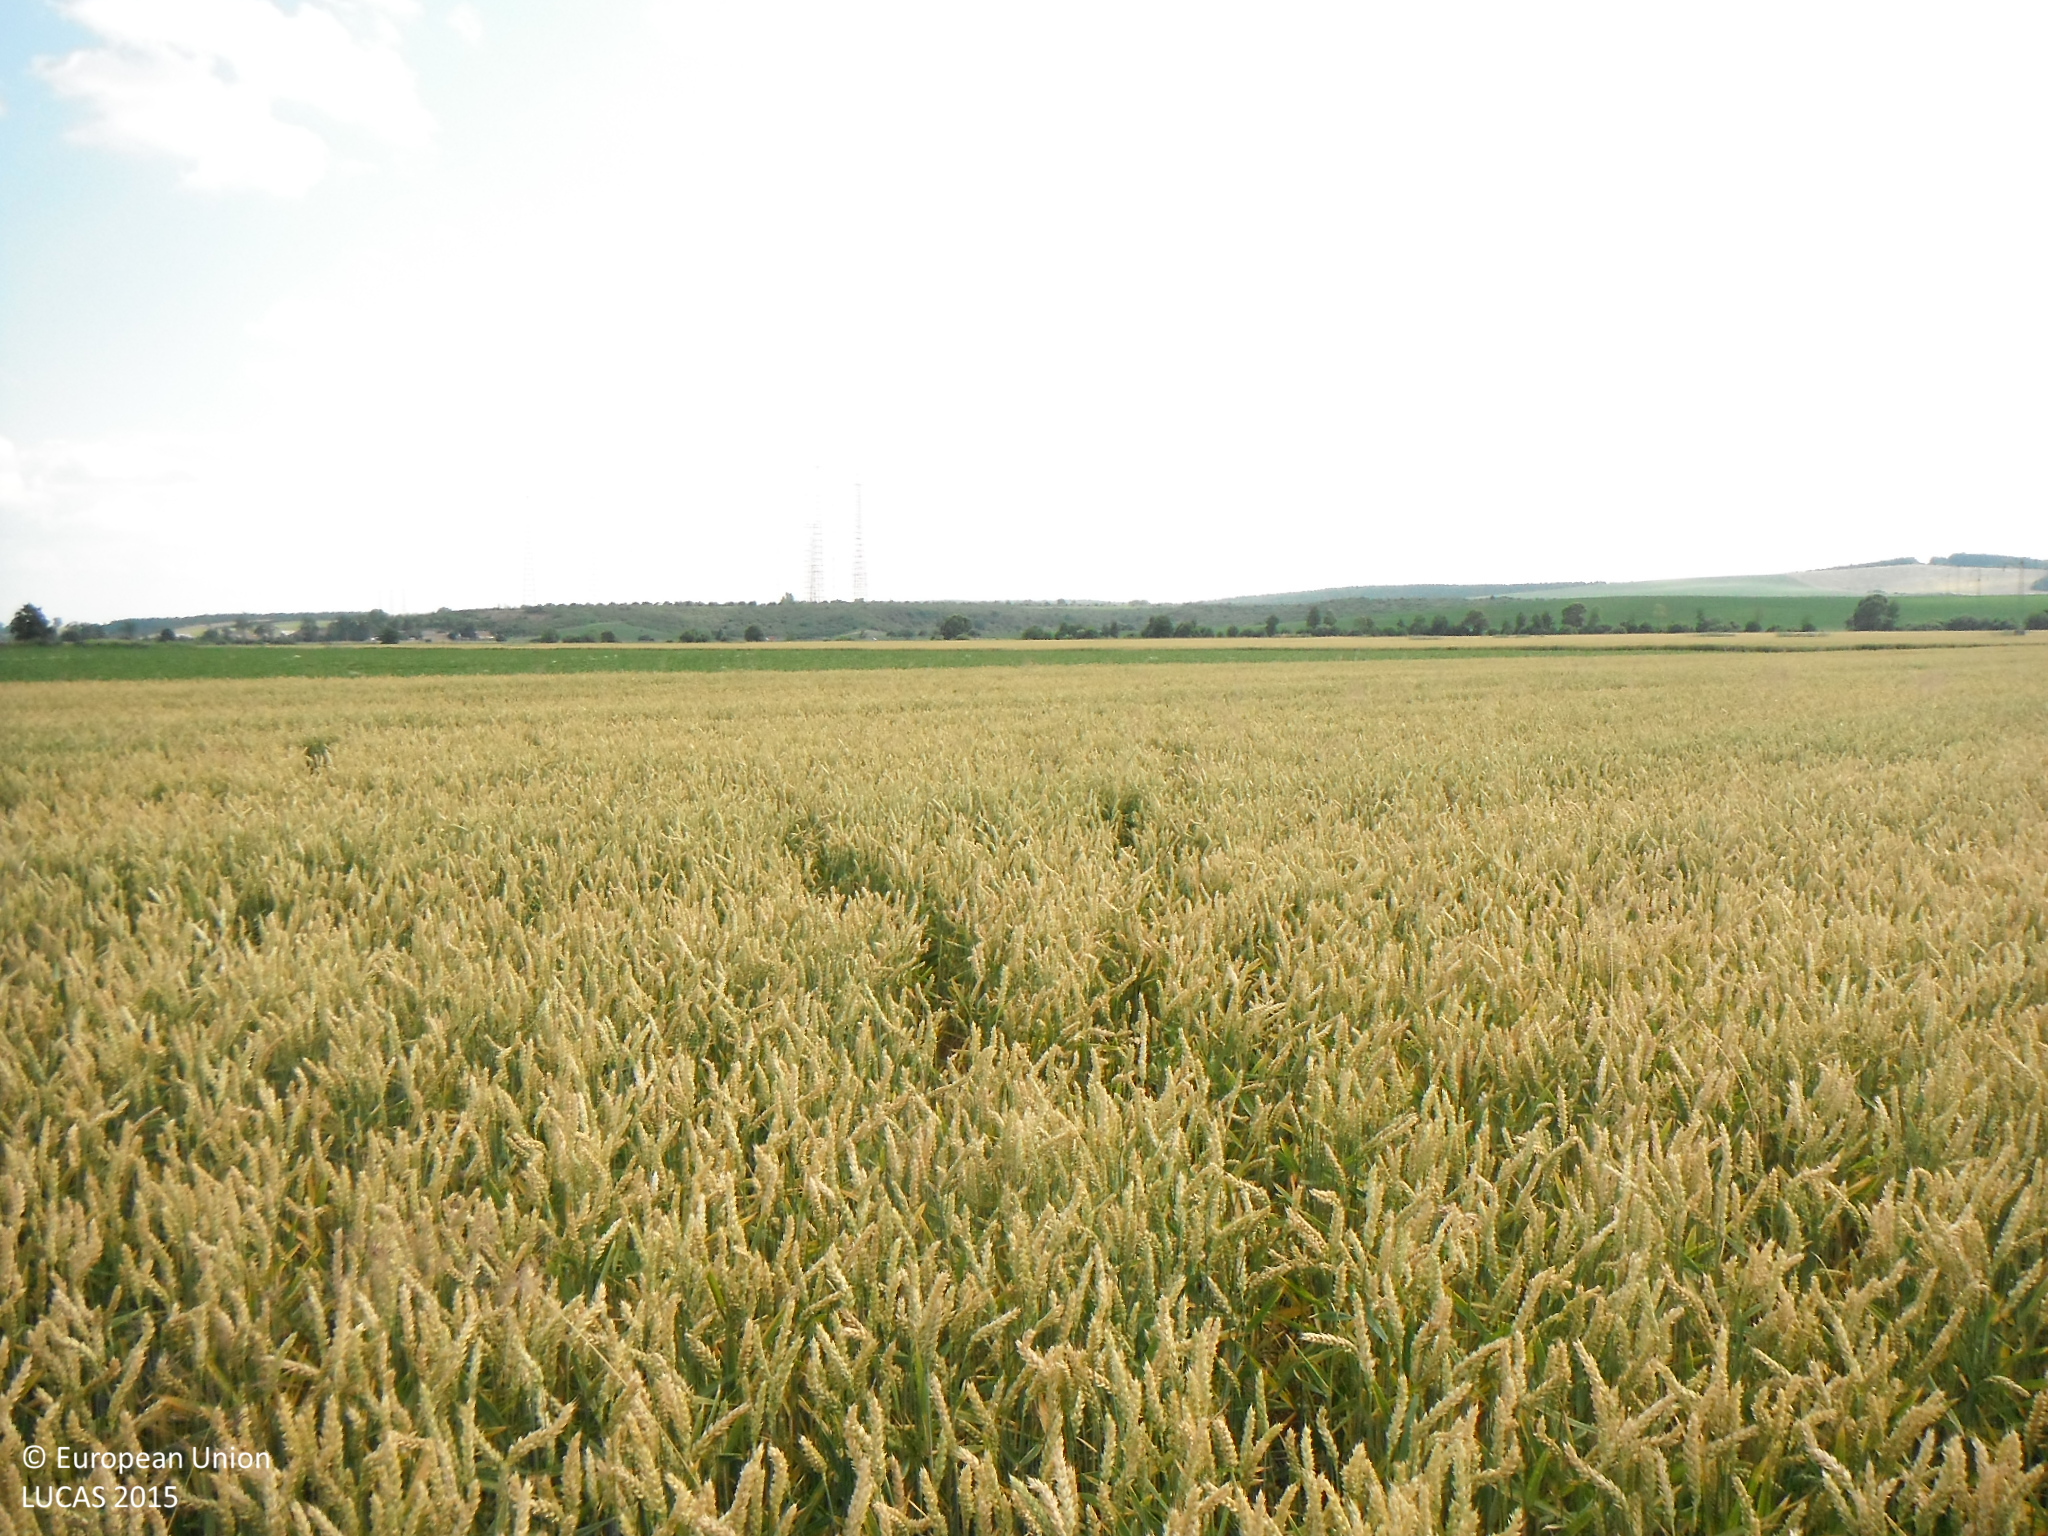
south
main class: Cropland
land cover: Common wheat
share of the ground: > 75 %
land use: Agriculture (excluding fallow land and kitchen gardens)
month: June
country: SK
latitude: 48.4270
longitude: 20.1258
